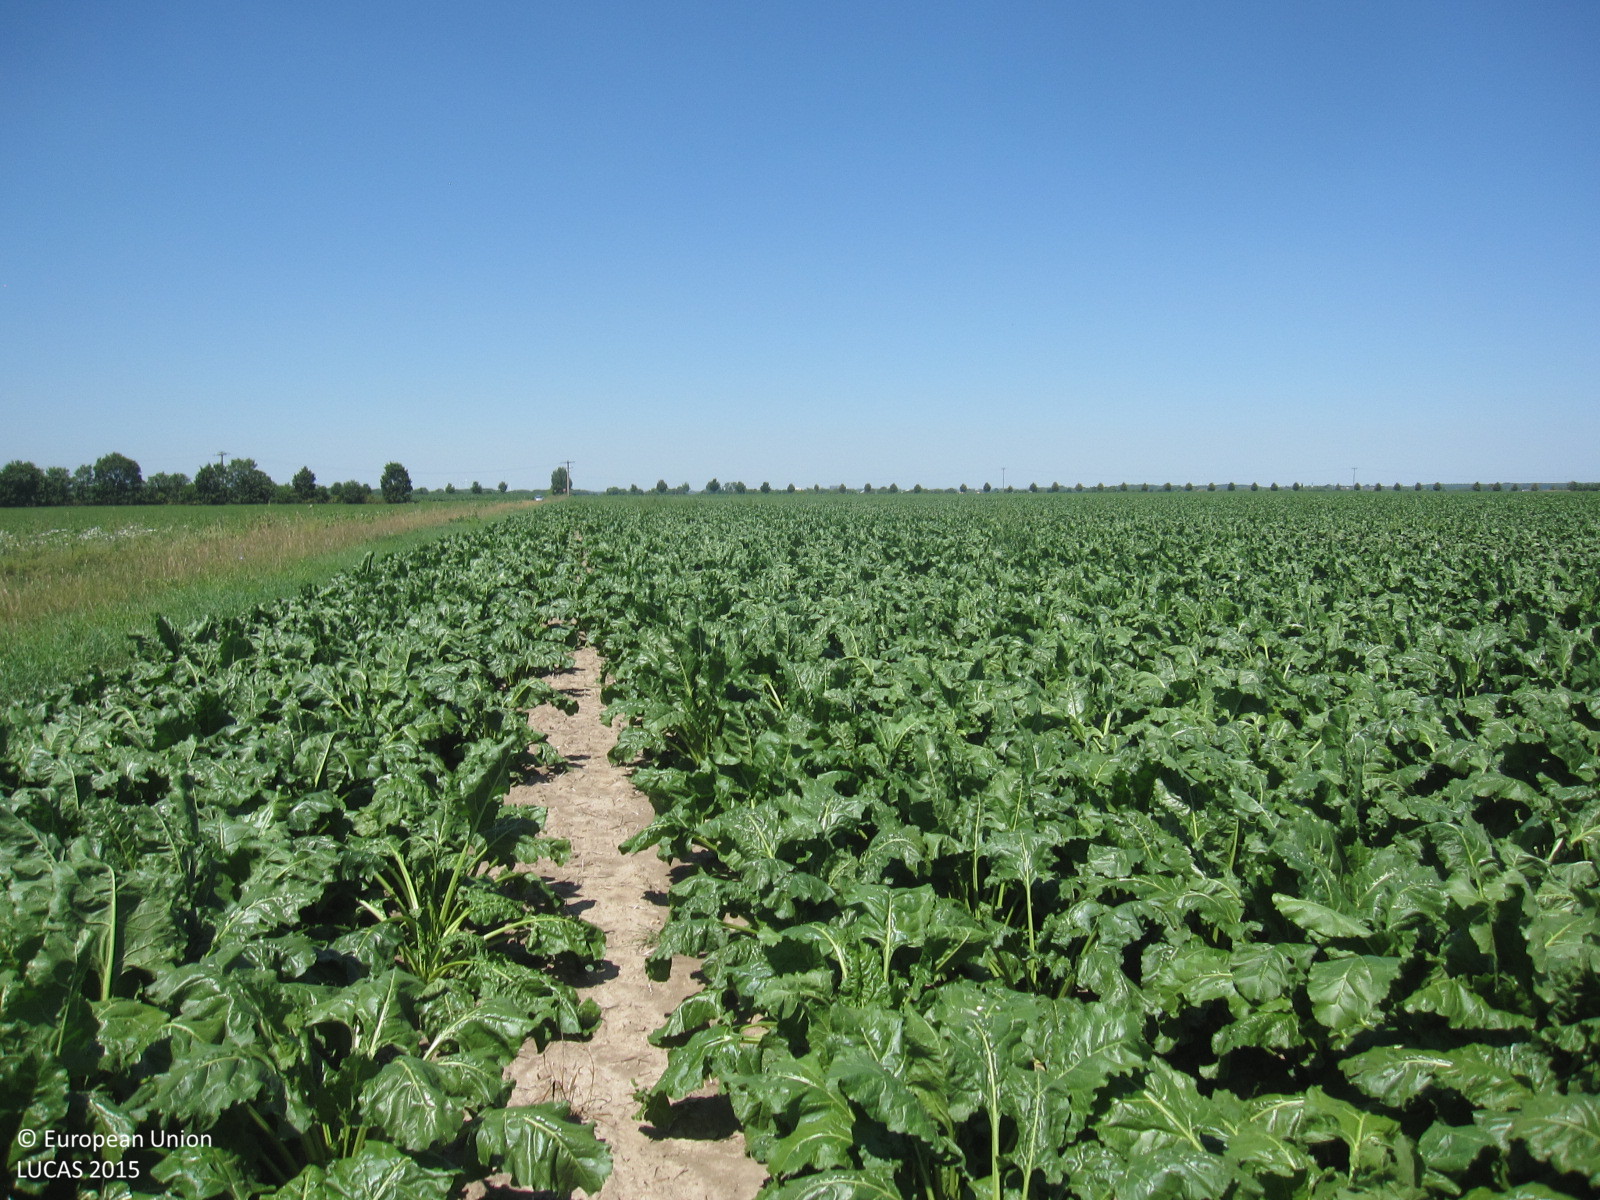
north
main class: Cropland
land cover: Sugar beet
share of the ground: > 75 %
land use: Agriculture (excluding fallow land and kitchen gardens)
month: July
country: DE
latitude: 51.2424
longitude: 12.1914
